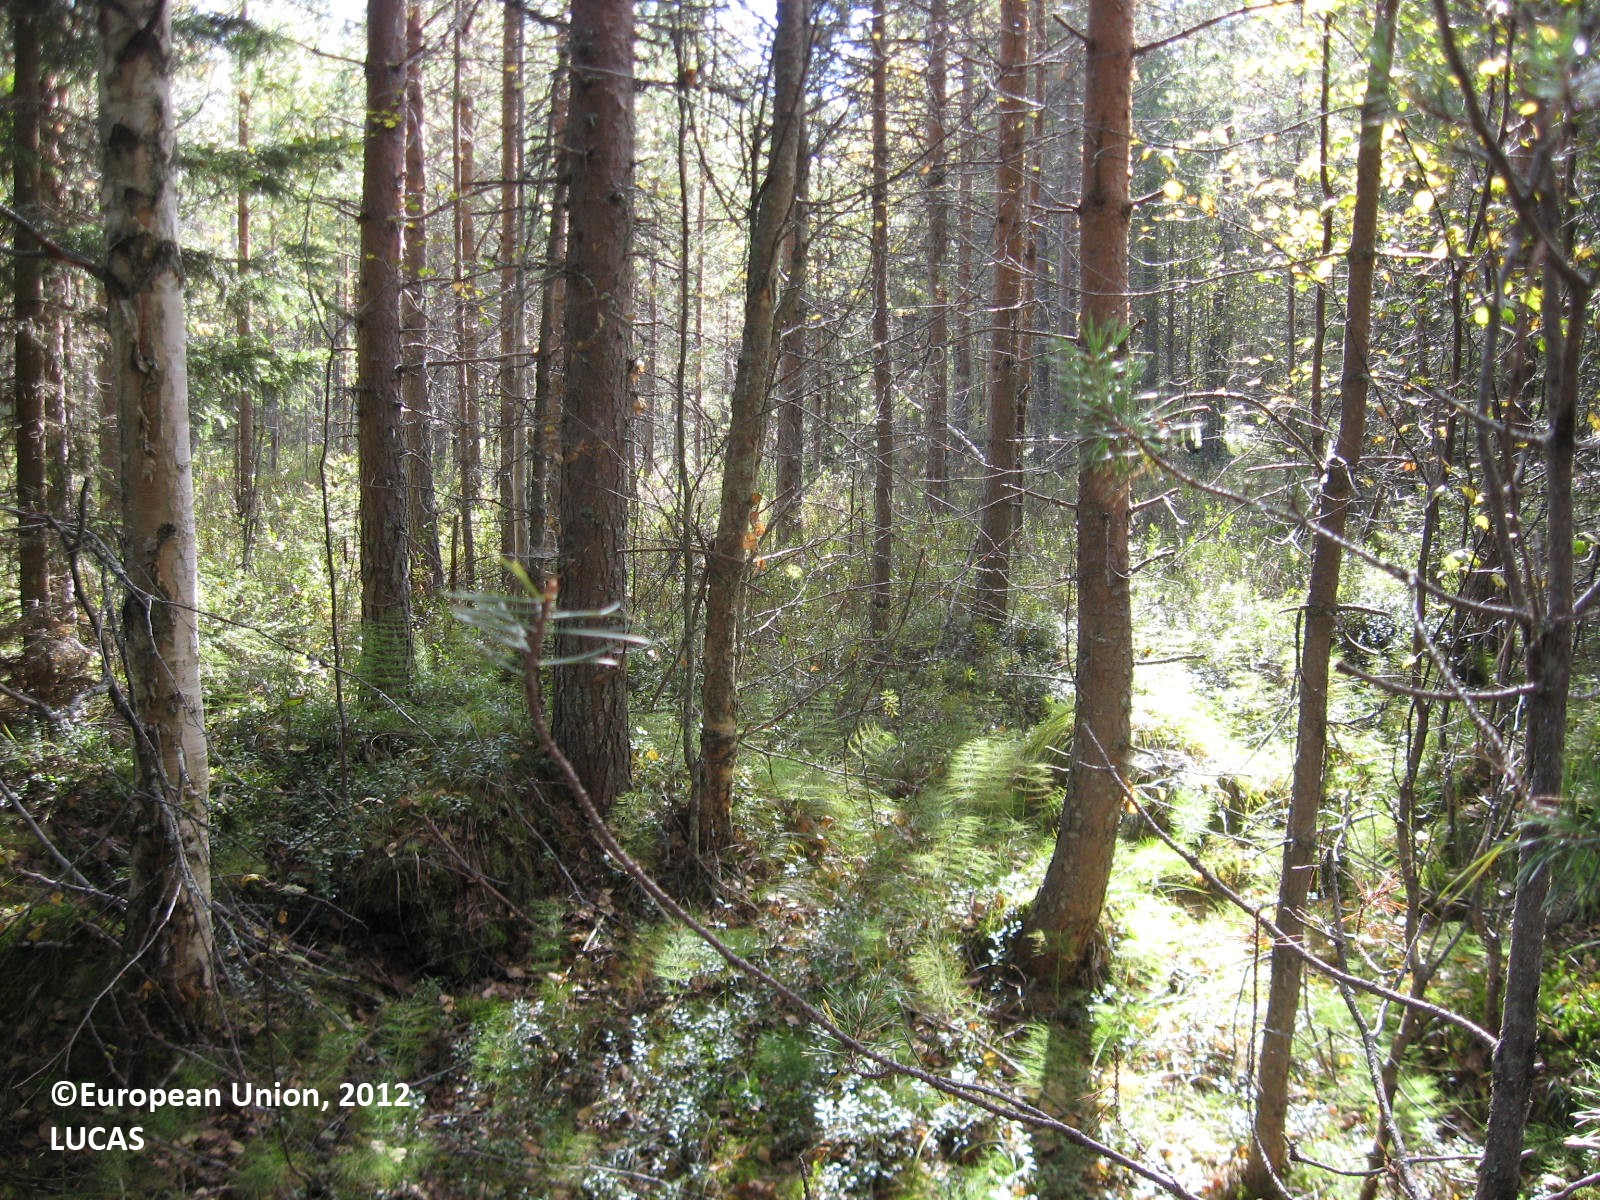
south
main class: Woodland
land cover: Other mixed woodland
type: boreal forest
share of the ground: > 75 %
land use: Forestry
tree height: > 5 m
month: August
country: FI
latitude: 63.9292
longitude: 30.1321
